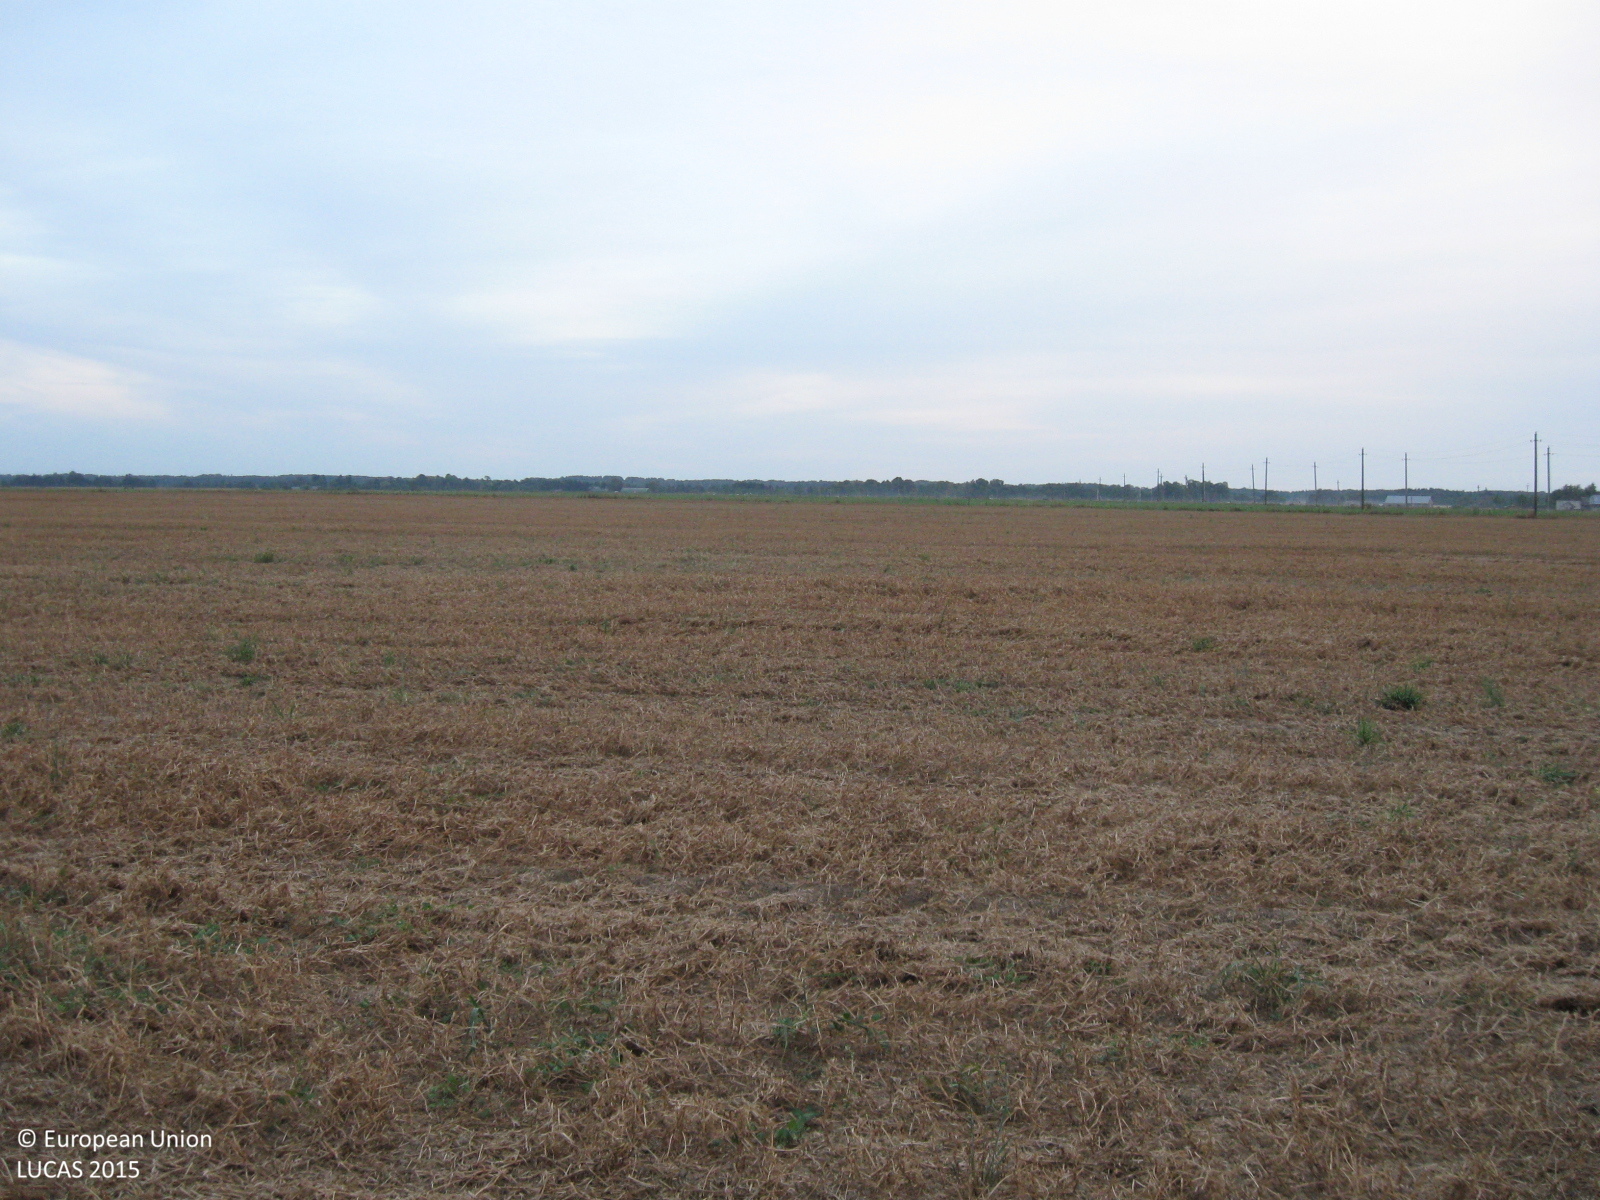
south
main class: Cropland
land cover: Dry pulses
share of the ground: 10 - 25 %
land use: Agriculture (excluding fallow land and kitchen gardens)
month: August
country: LT
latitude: 55.1816
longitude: 23.1230
